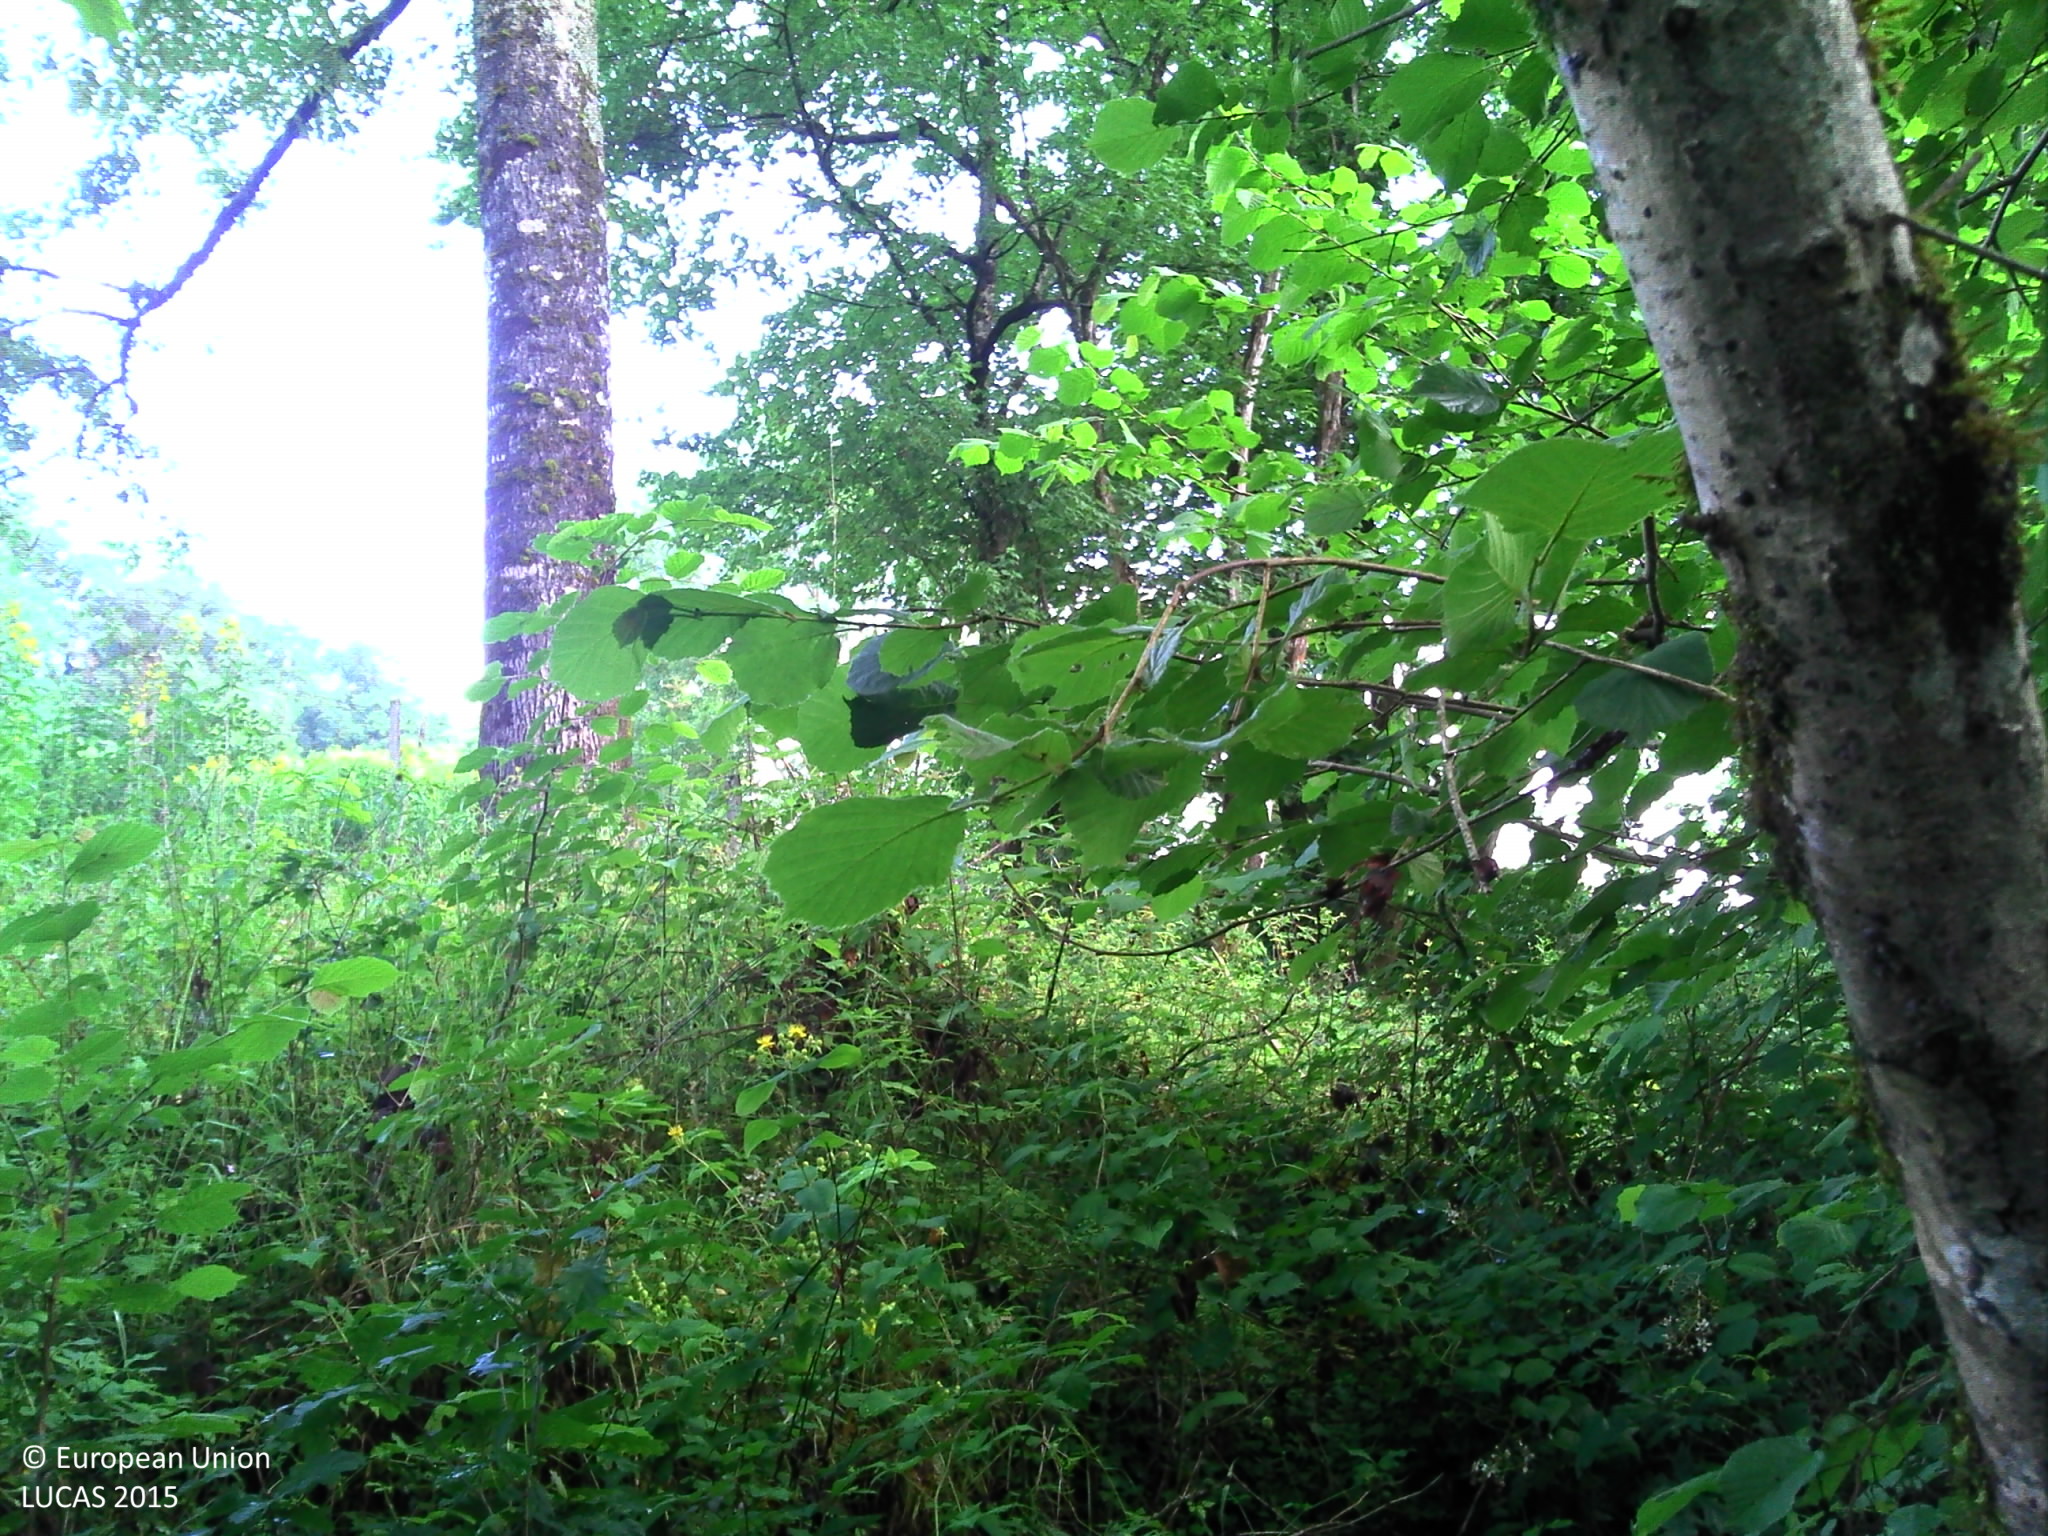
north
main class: Woodland
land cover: Broadleaved woodland
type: acidophilous oak and oak-birch forest
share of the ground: > 75 %
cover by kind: broadleaved forest trees 70 %, shrubs 10 %, herbaceous plants 10 %, lichens and mosses 10 %
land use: Forestry
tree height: > 5 m
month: June
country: FR
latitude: 43.2183
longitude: -0.6570
